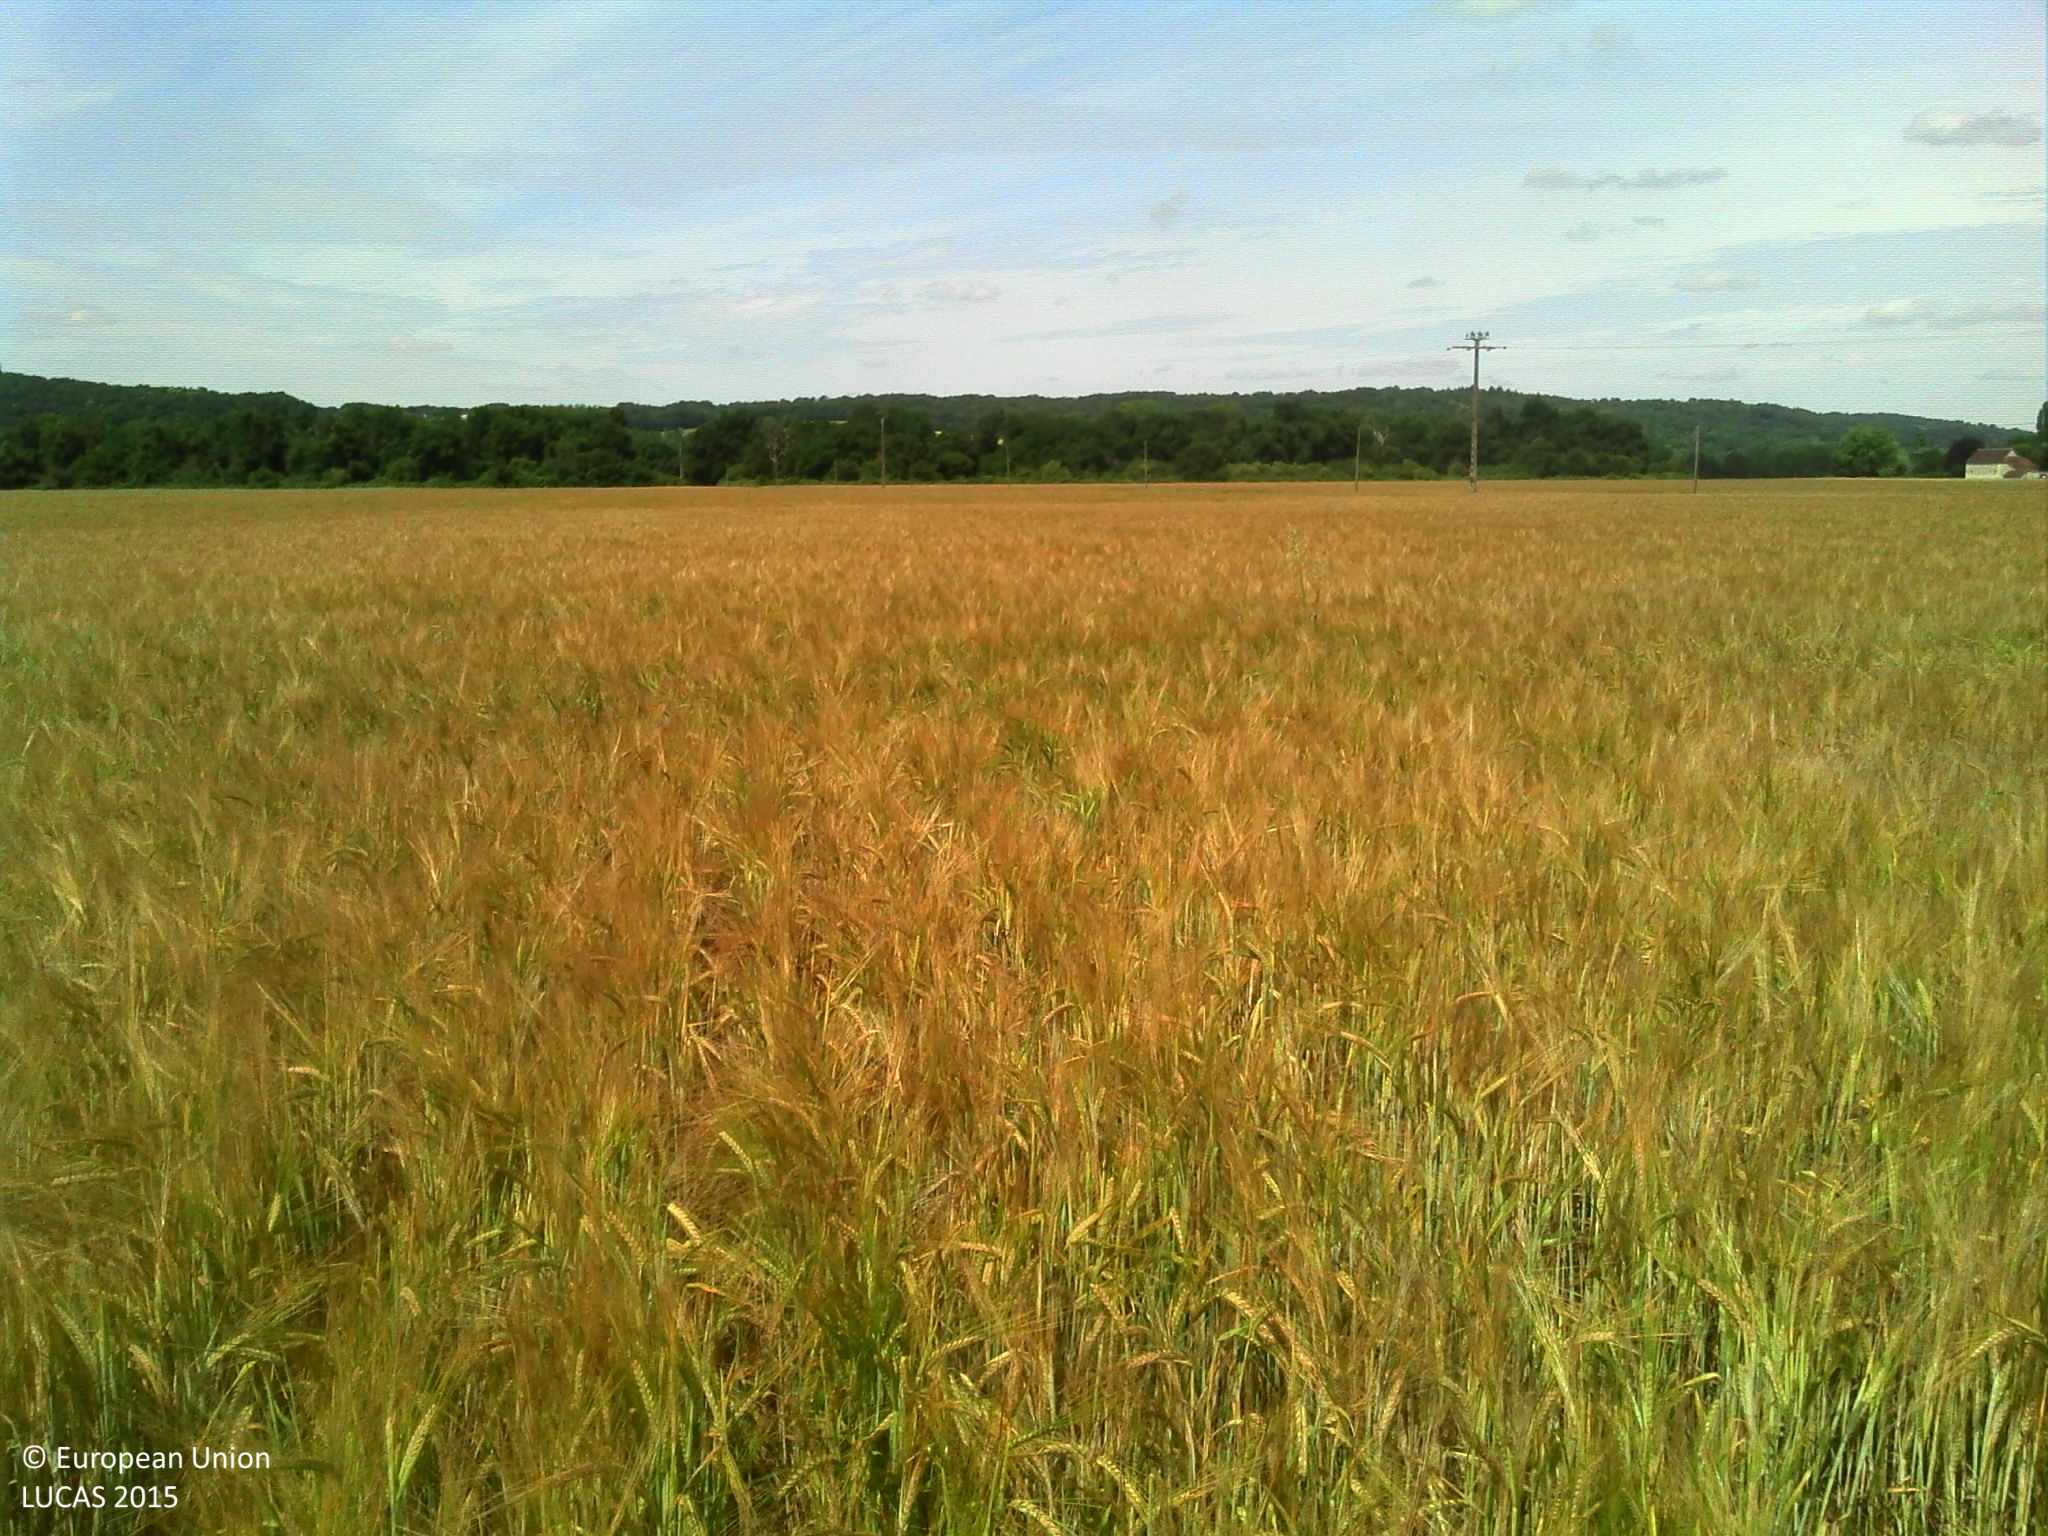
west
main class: Cropland
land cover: Barley
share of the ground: > 75 %
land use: Agriculture (excluding fallow land and kitchen gardens)
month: June
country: FR
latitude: 46.8256
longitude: 0.8208
